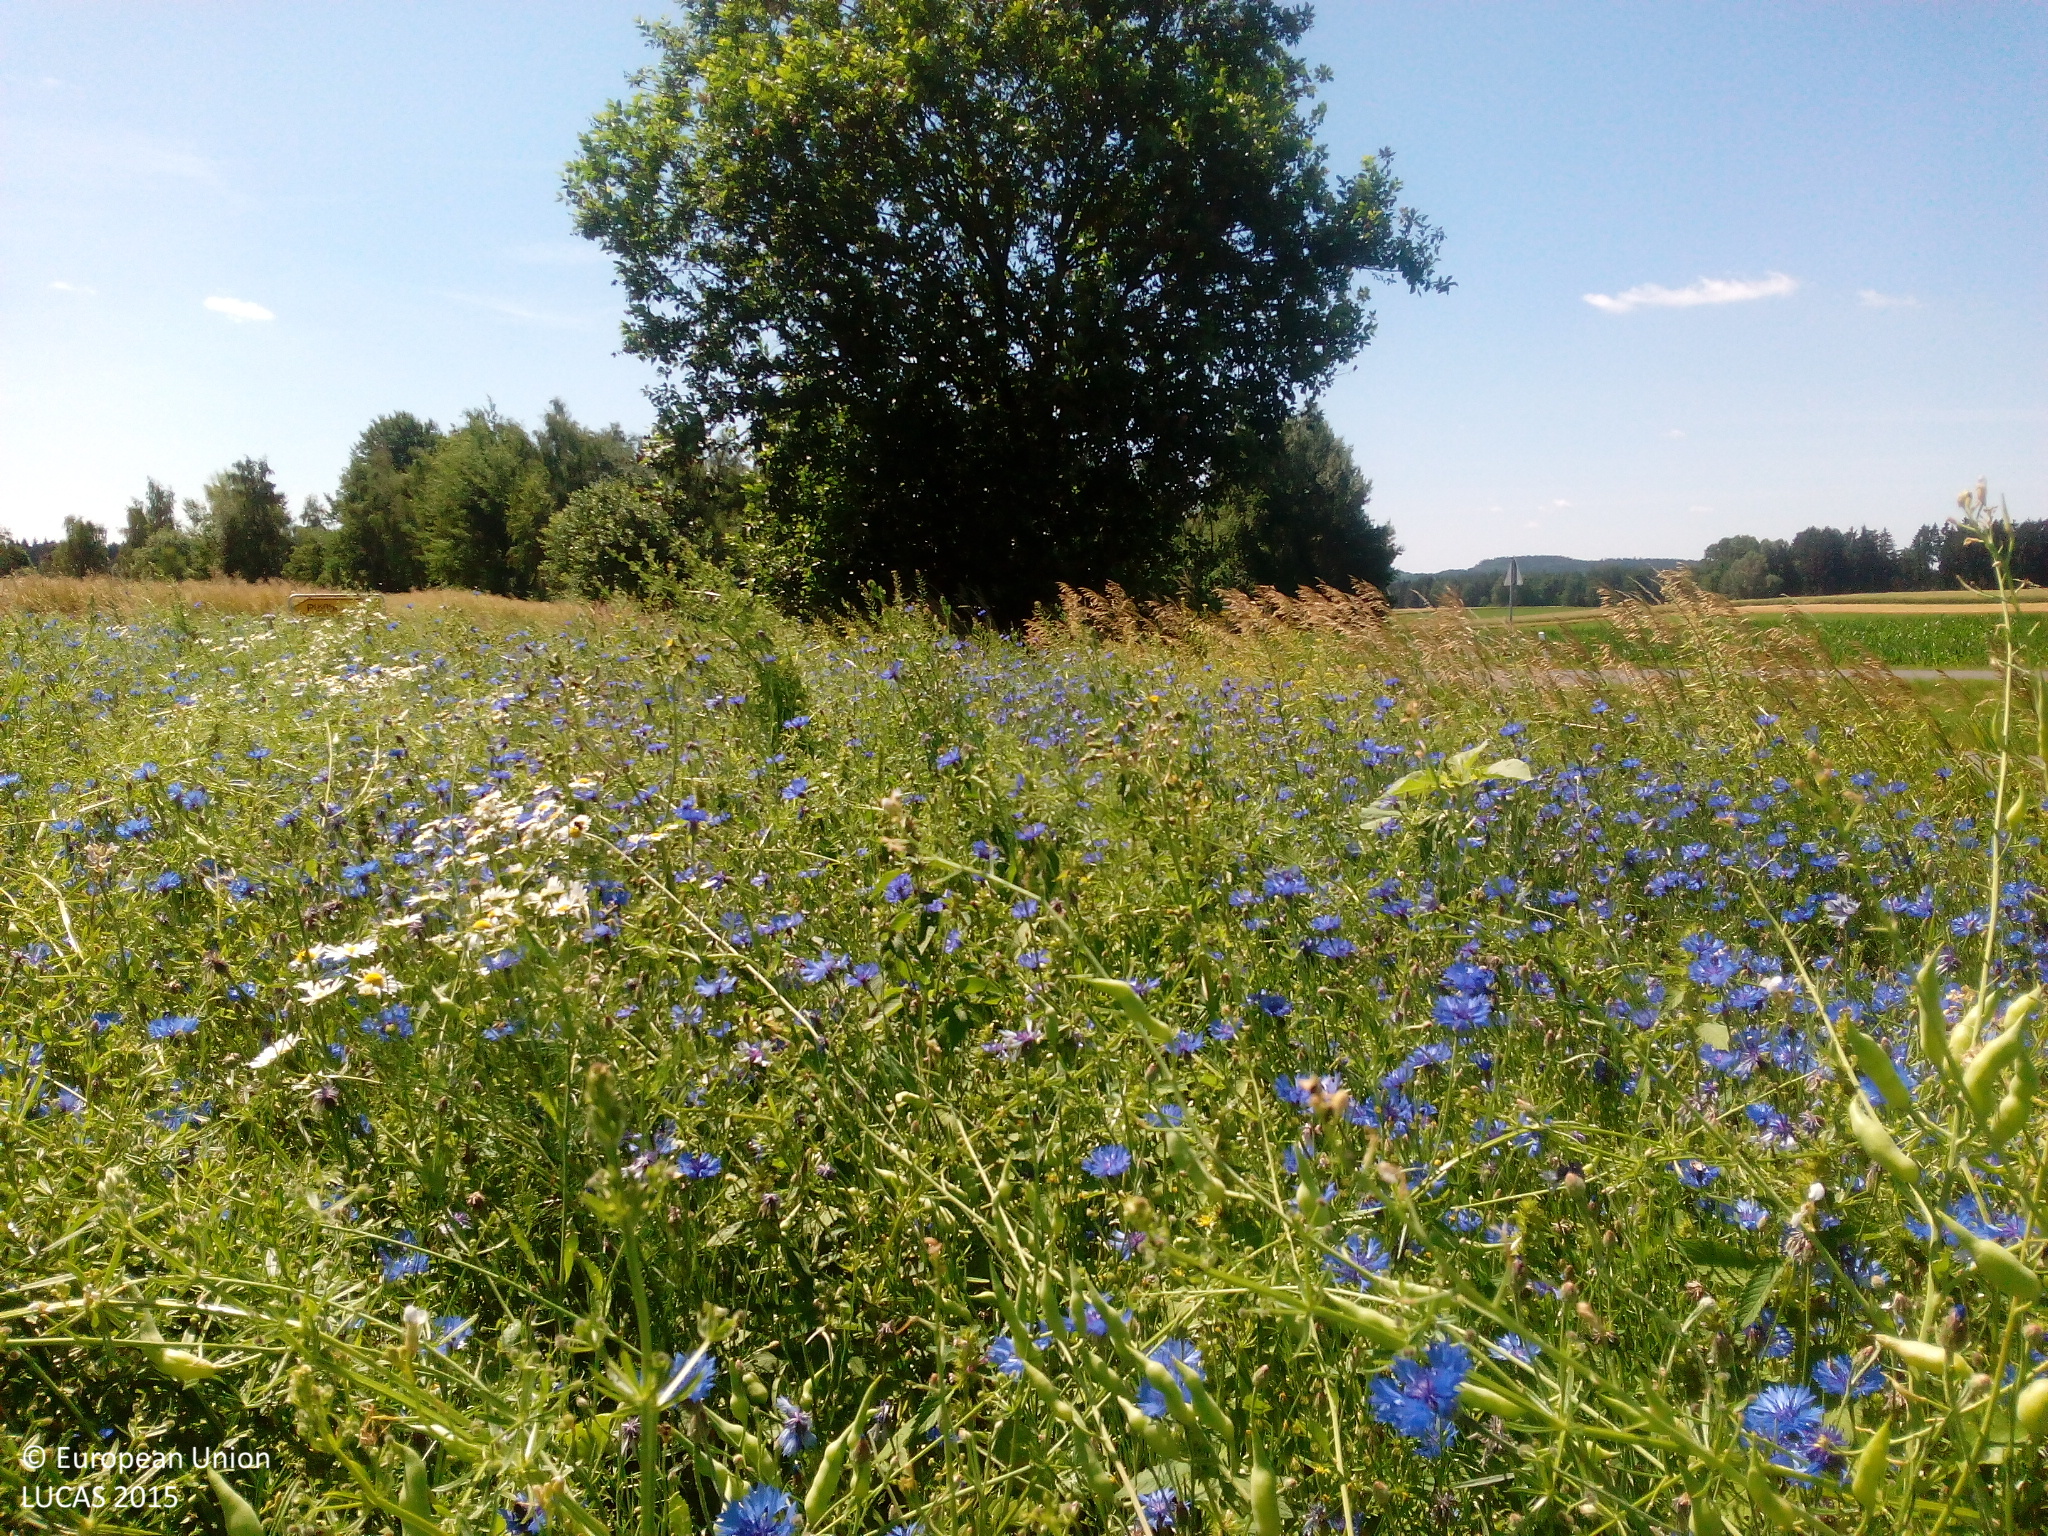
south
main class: Cropland
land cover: Dry pulses
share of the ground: > 75 %
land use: Agriculture (excluding fallow land and kitchen gardens)
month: July
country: DE
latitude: 49.7486
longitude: 12.2340
